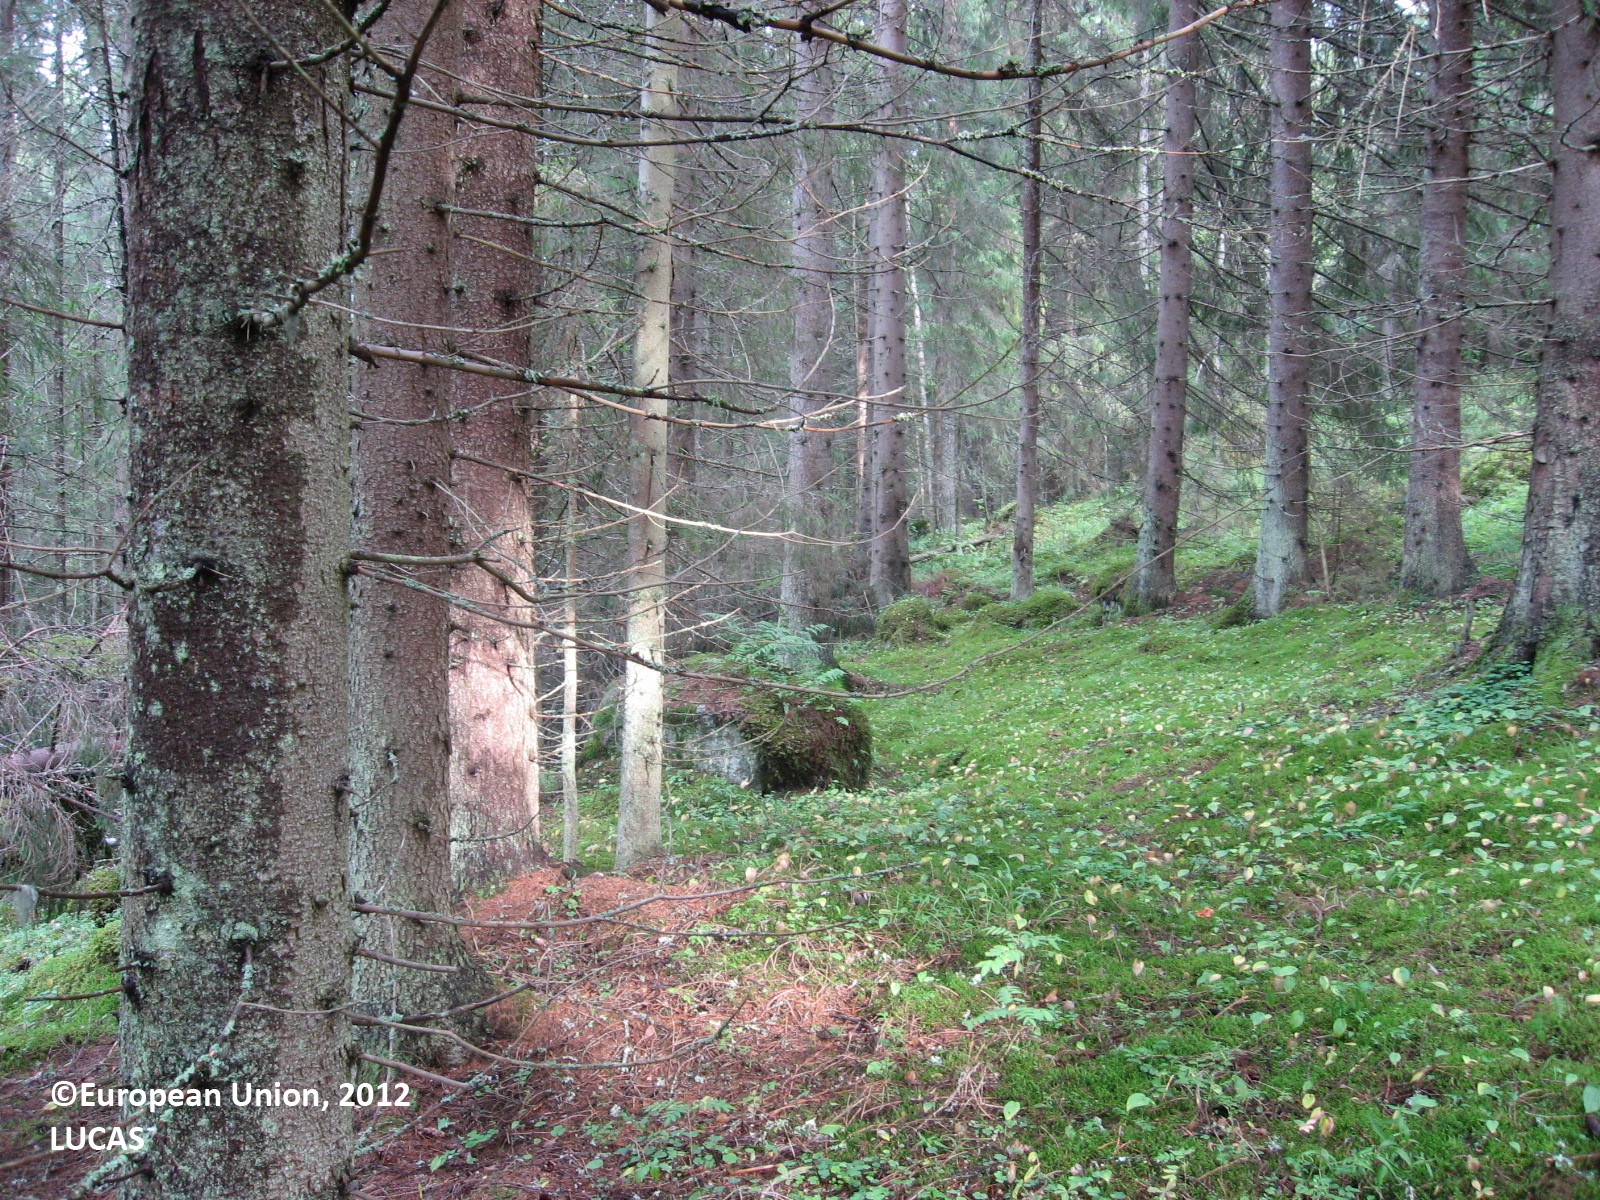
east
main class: Woodland
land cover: Spruce dominated coniferous woodland
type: boreal forest
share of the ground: > 75 %
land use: Forestry
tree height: > 5 m
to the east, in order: Spruce dominated coniferous woodland; Ditches and canals; Spruce dominated mixed woodland; Ditches and canals; Spruce dominated mixed woodland; Ditches and canals; Spruce dominated mixed woodland; Ditches and canals; Spruce dominated mixed woodland
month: August
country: FI
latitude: 61.1318
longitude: 24.8710
